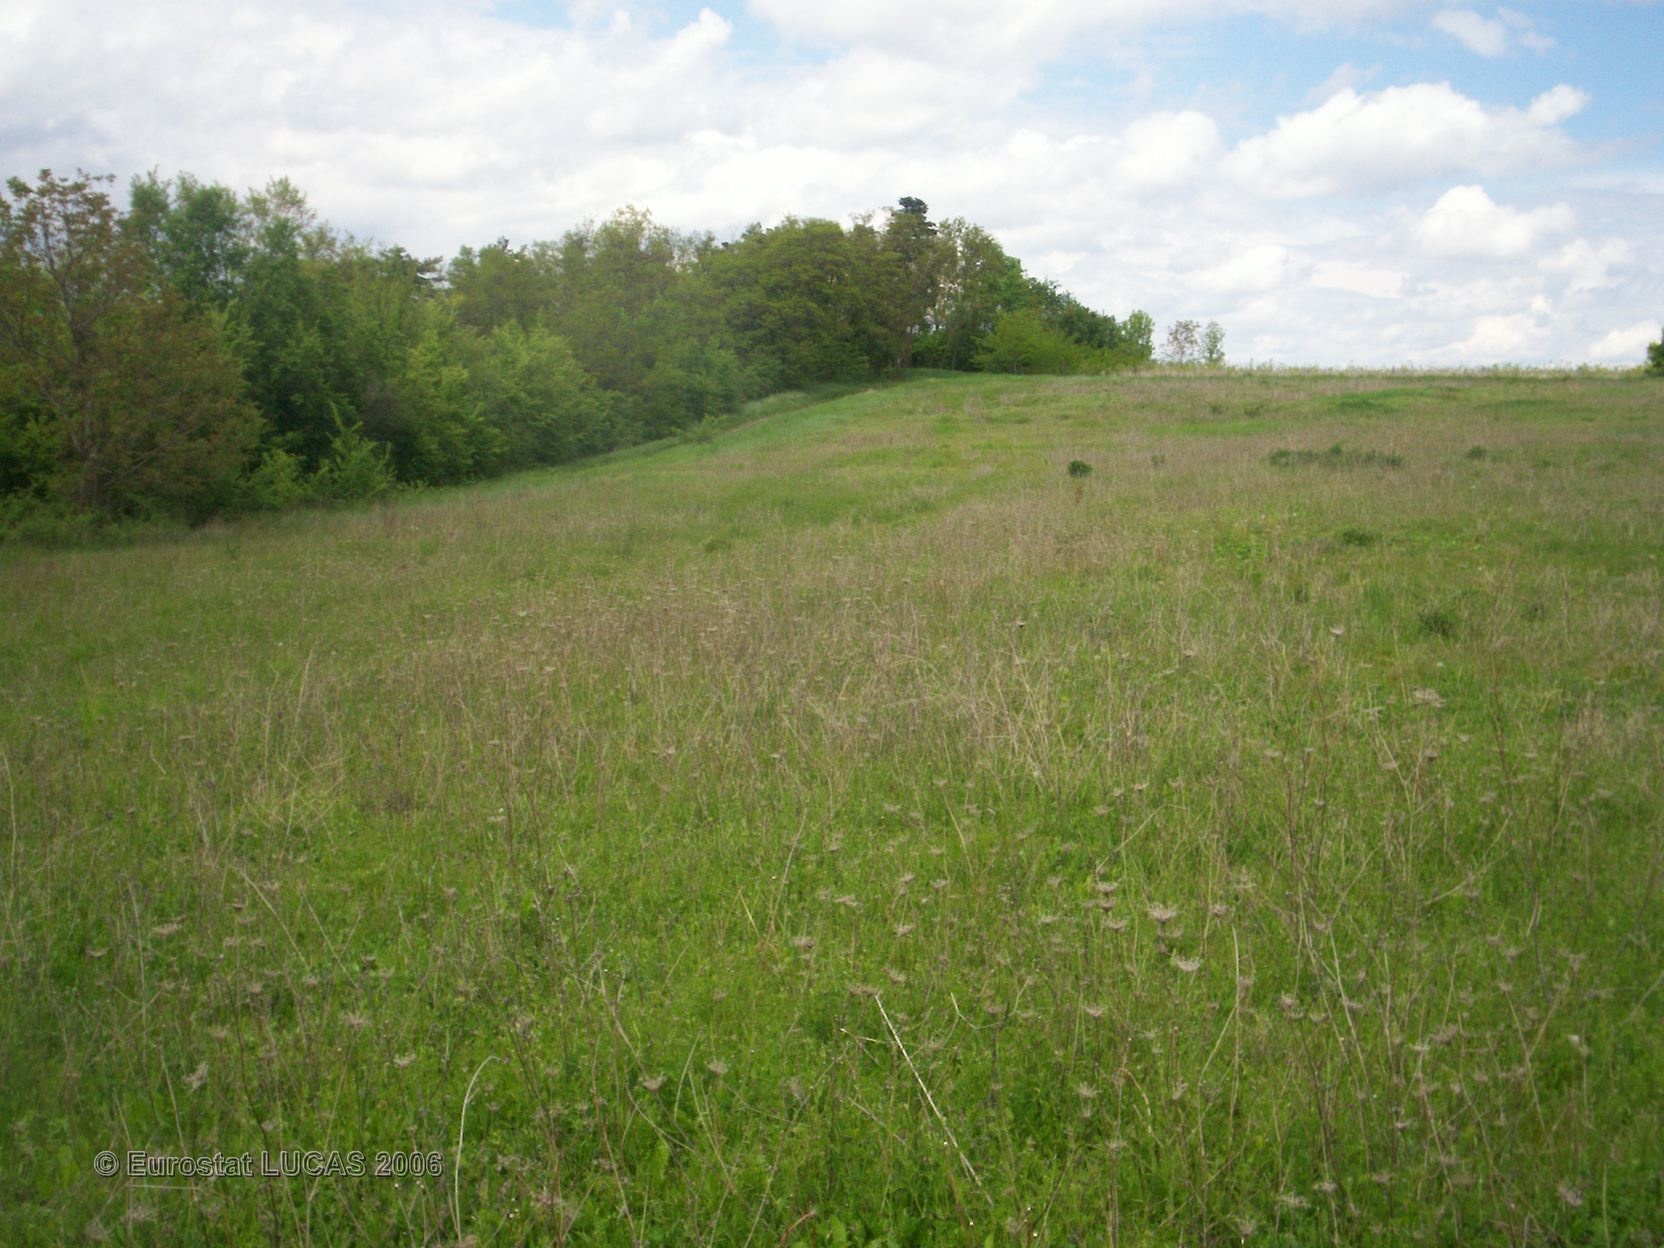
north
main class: Grassland
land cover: Grassland without tree/shrub cover
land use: Agriculture (excluding fallow land and kitchen gardens)
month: May
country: FR
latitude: 45.6996
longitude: 3.1806
